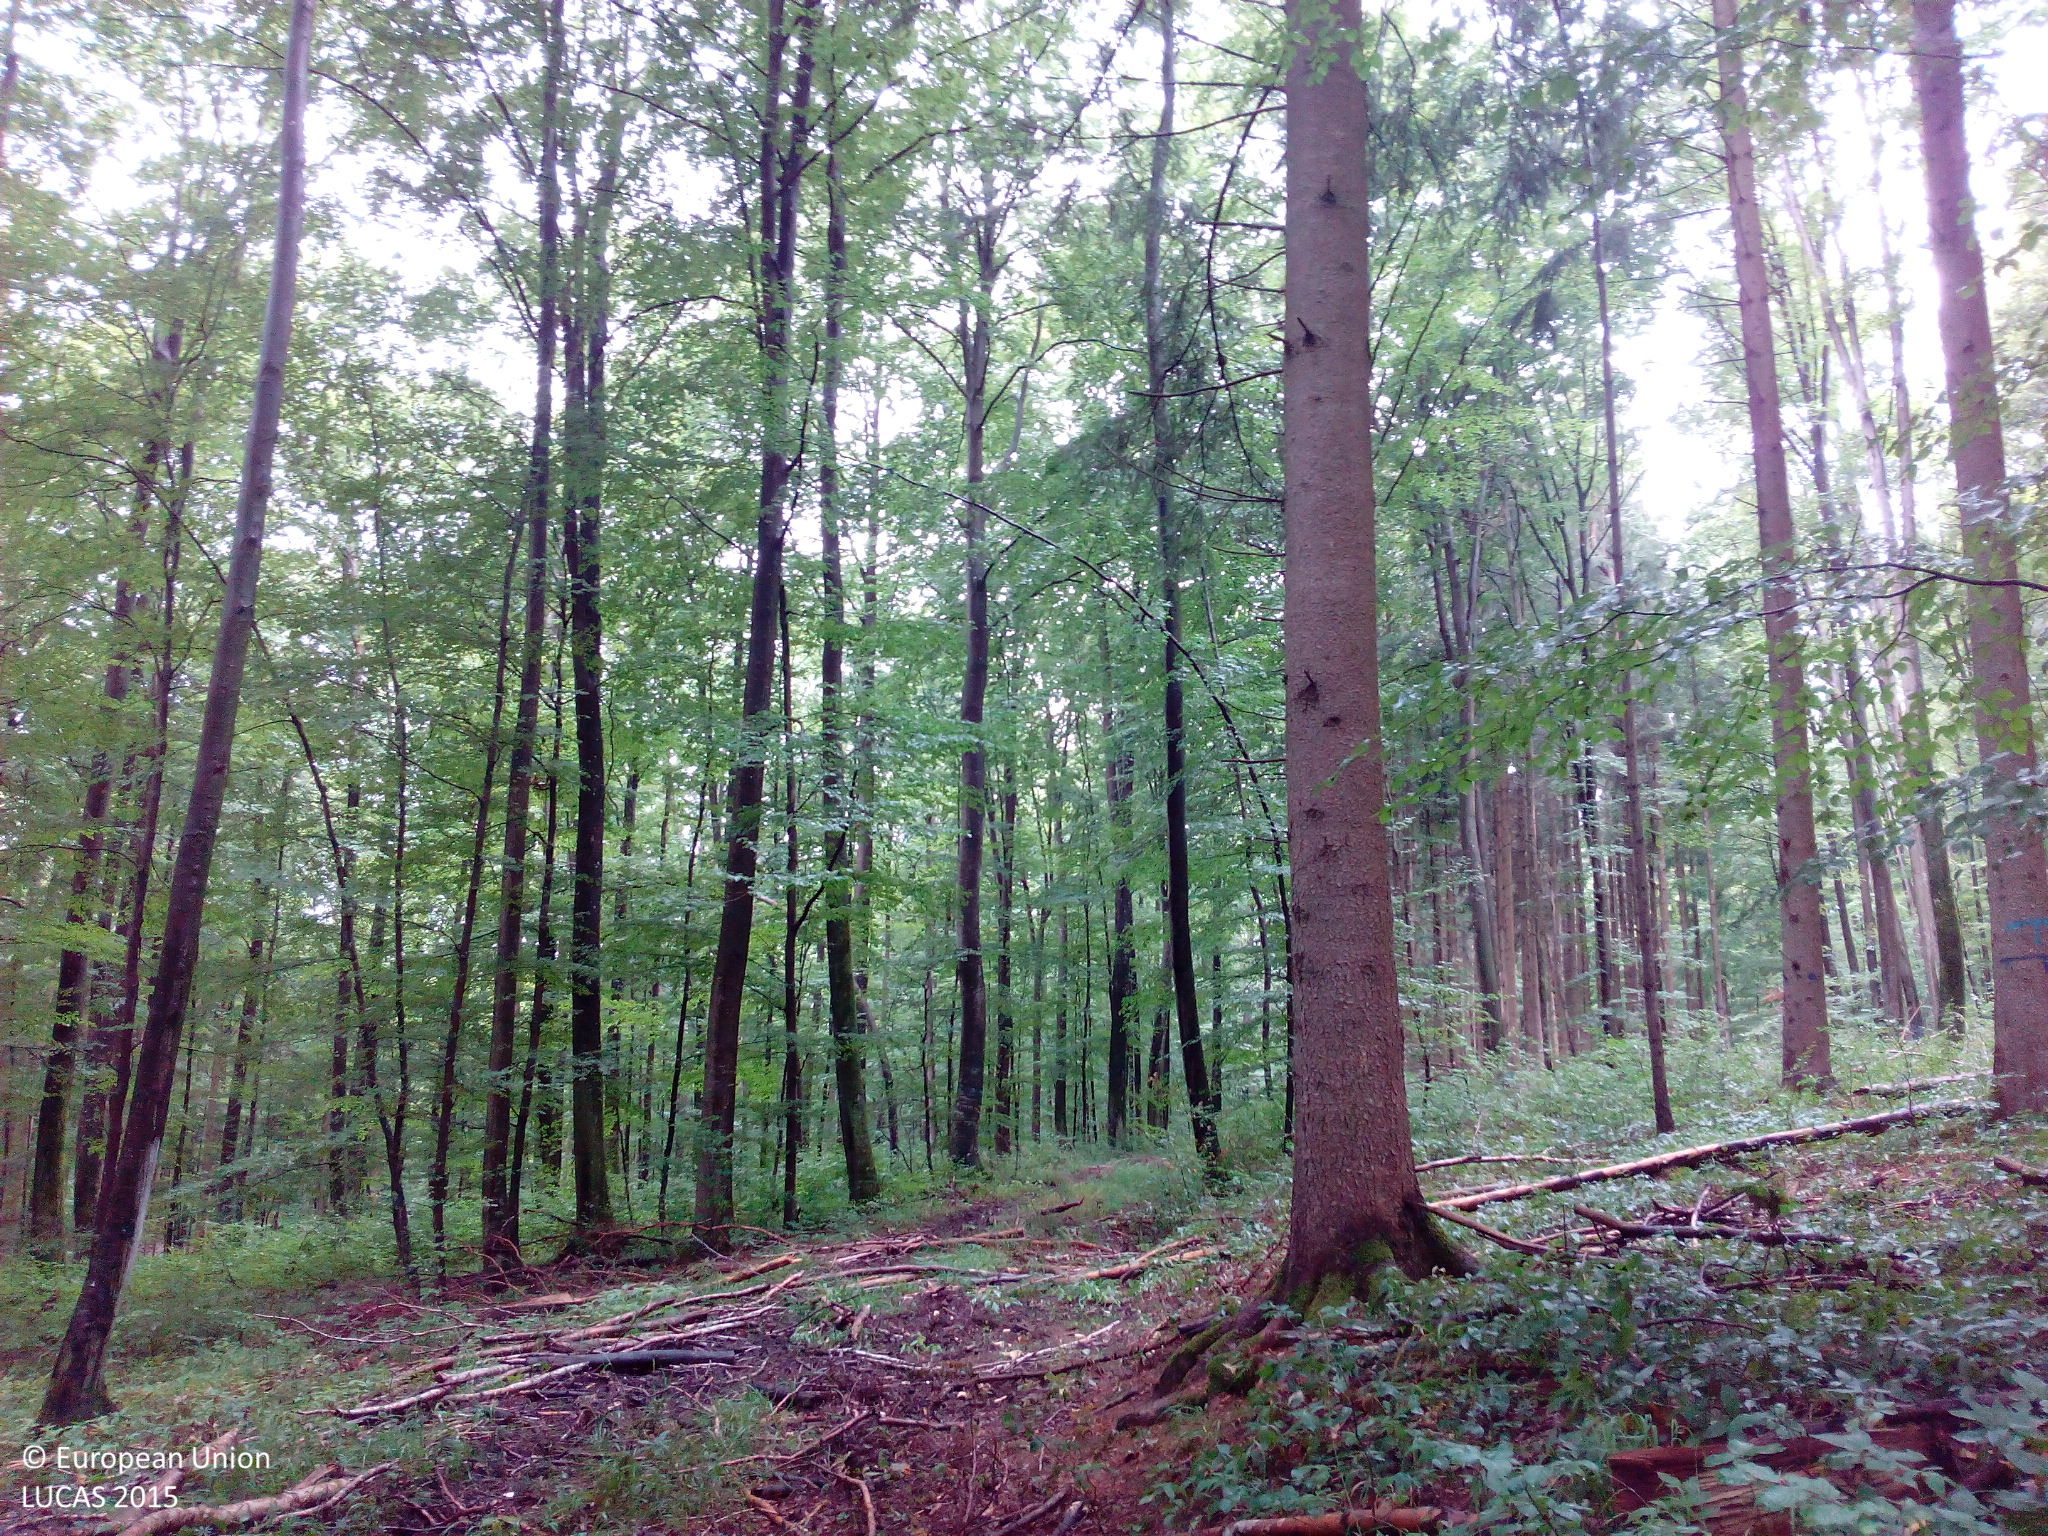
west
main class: Woodland
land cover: Broadleaved woodland
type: mesophytic deciduous forest
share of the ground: > 75 %
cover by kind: broadleaved forest trees 70 %, coniferous forest trees 15 %, shrubs 10 %, unconsolidated bare surface 5 %
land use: Forestry
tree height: > 5 m
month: August
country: DE
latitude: 48.5474
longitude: 9.9594
